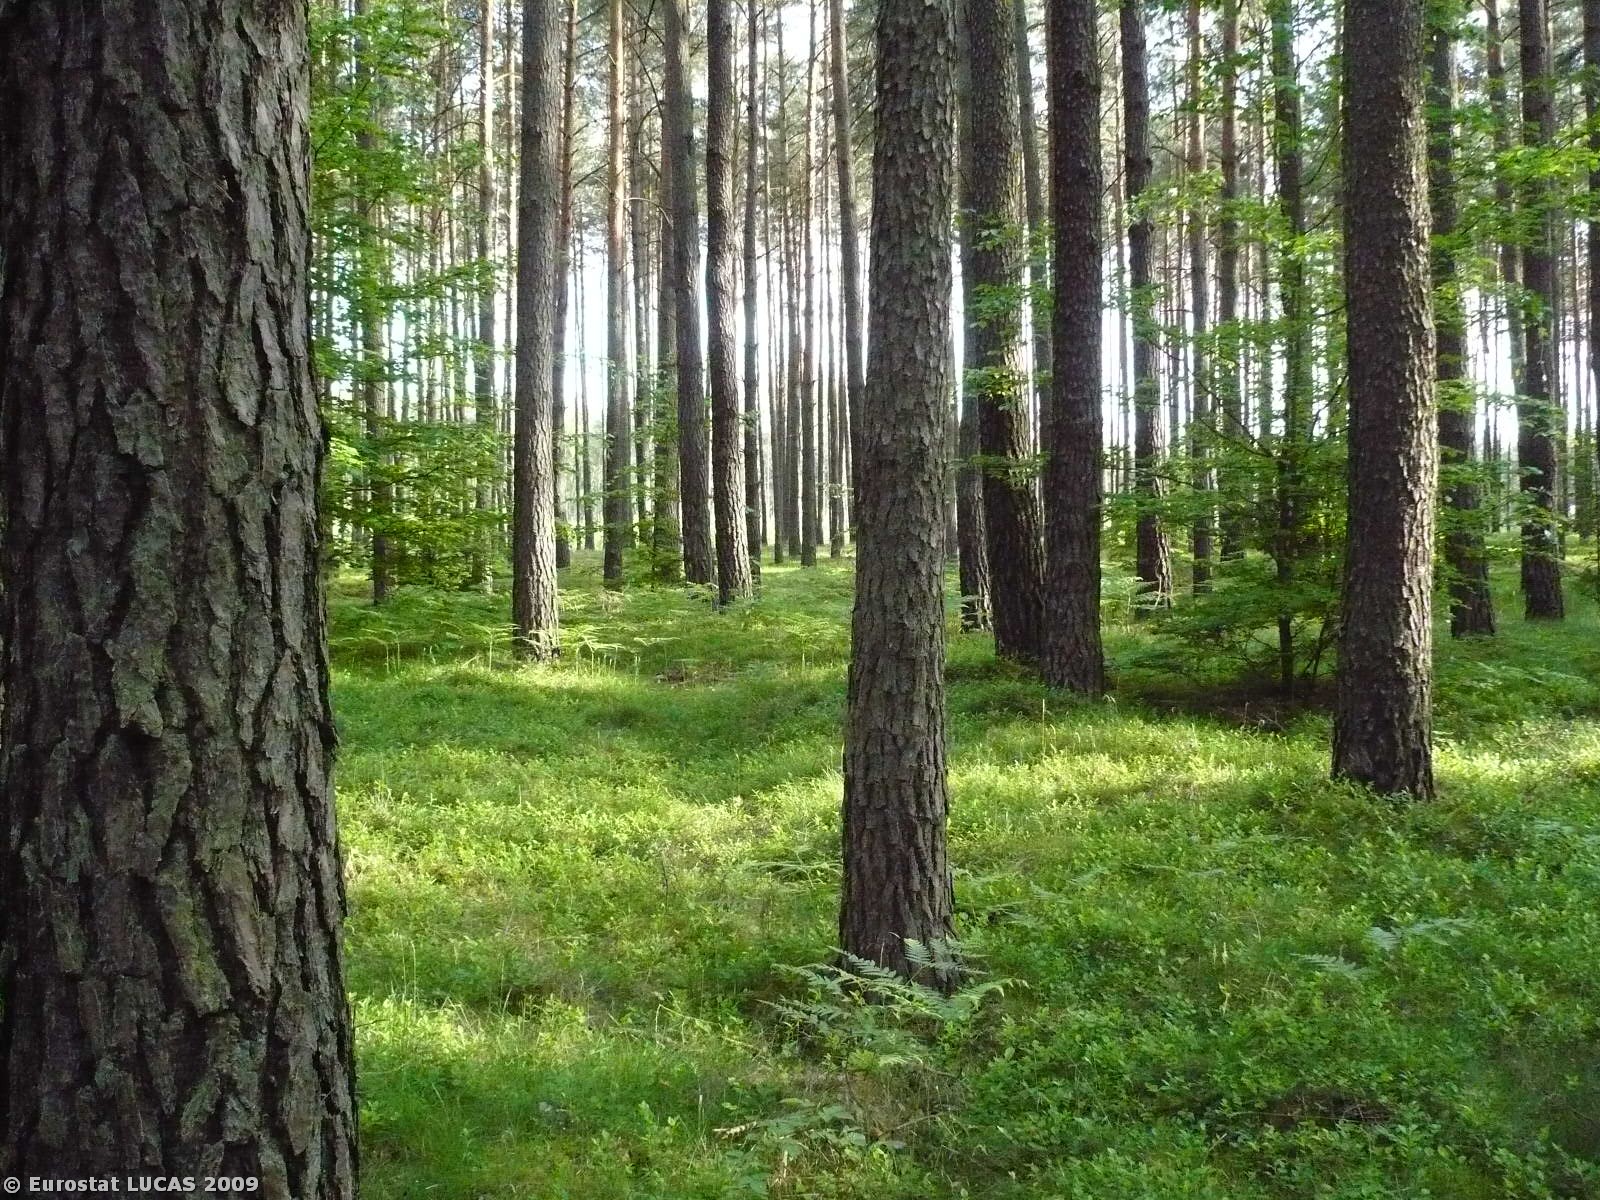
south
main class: Woodland
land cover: Coniferous woodland
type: hemiboreal forest and nemoral coniferous forest and mixed broadleaved-coniferous forest
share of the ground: > 75 %
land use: Forestry
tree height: > 5 m
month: May
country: PL
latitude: 52.1008
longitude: 15.2150
